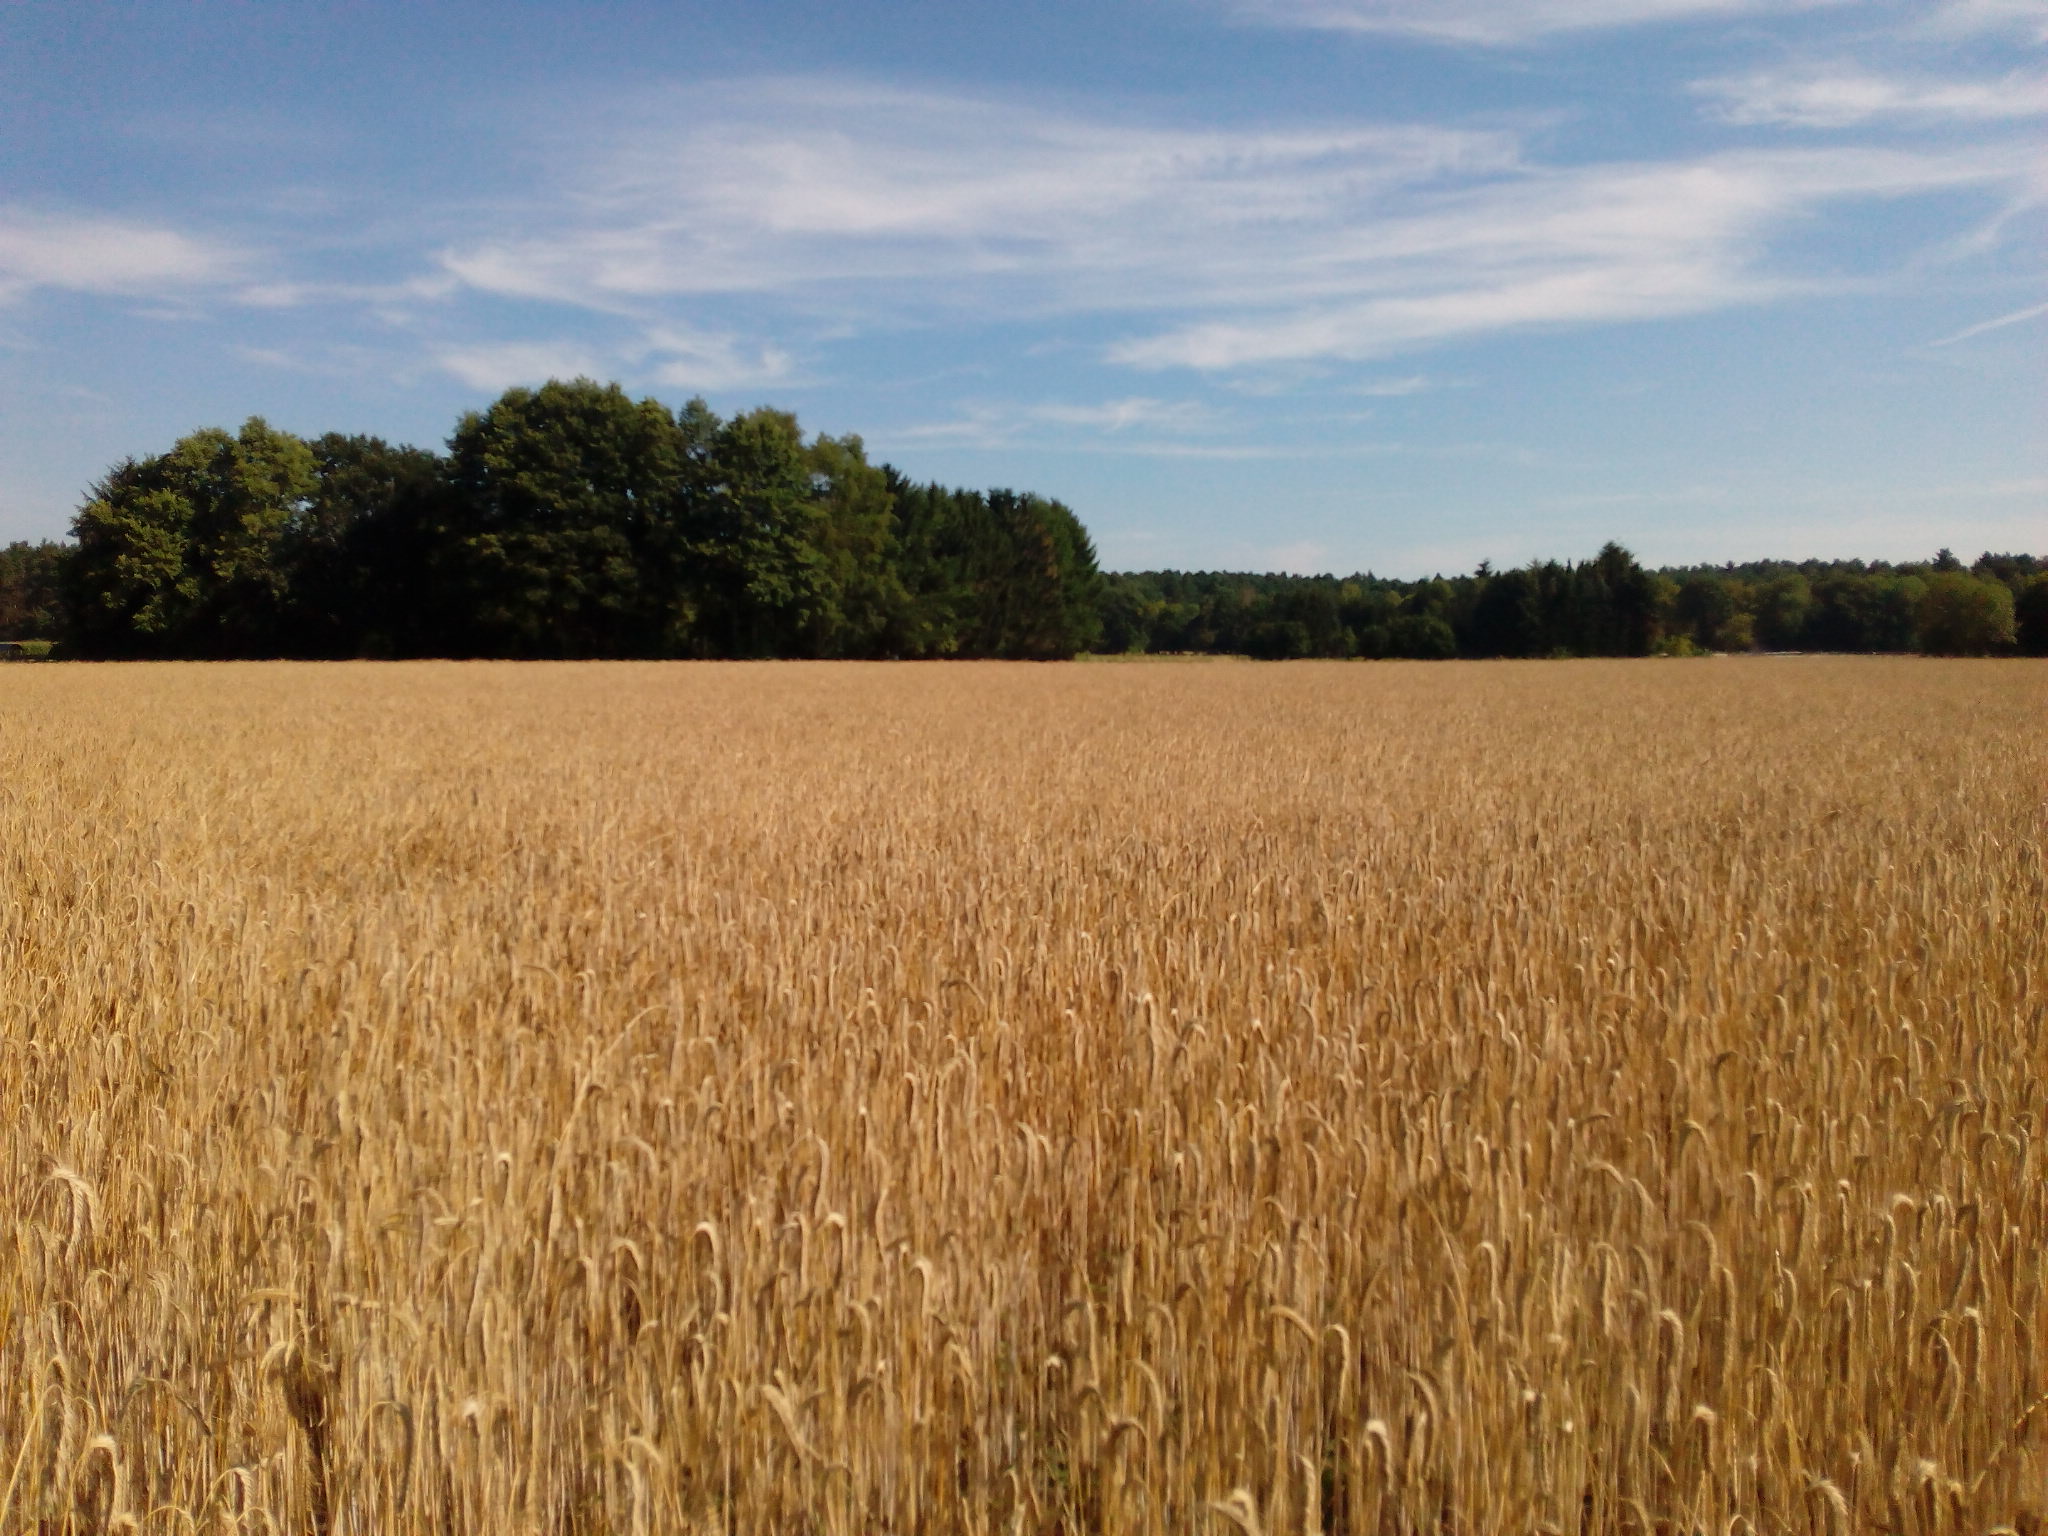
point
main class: Cropland
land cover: Rye
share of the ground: > 75 %
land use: Agriculture (excluding fallow land and kitchen gardens)
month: August
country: DE
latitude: 52.5212
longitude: 9.8969
